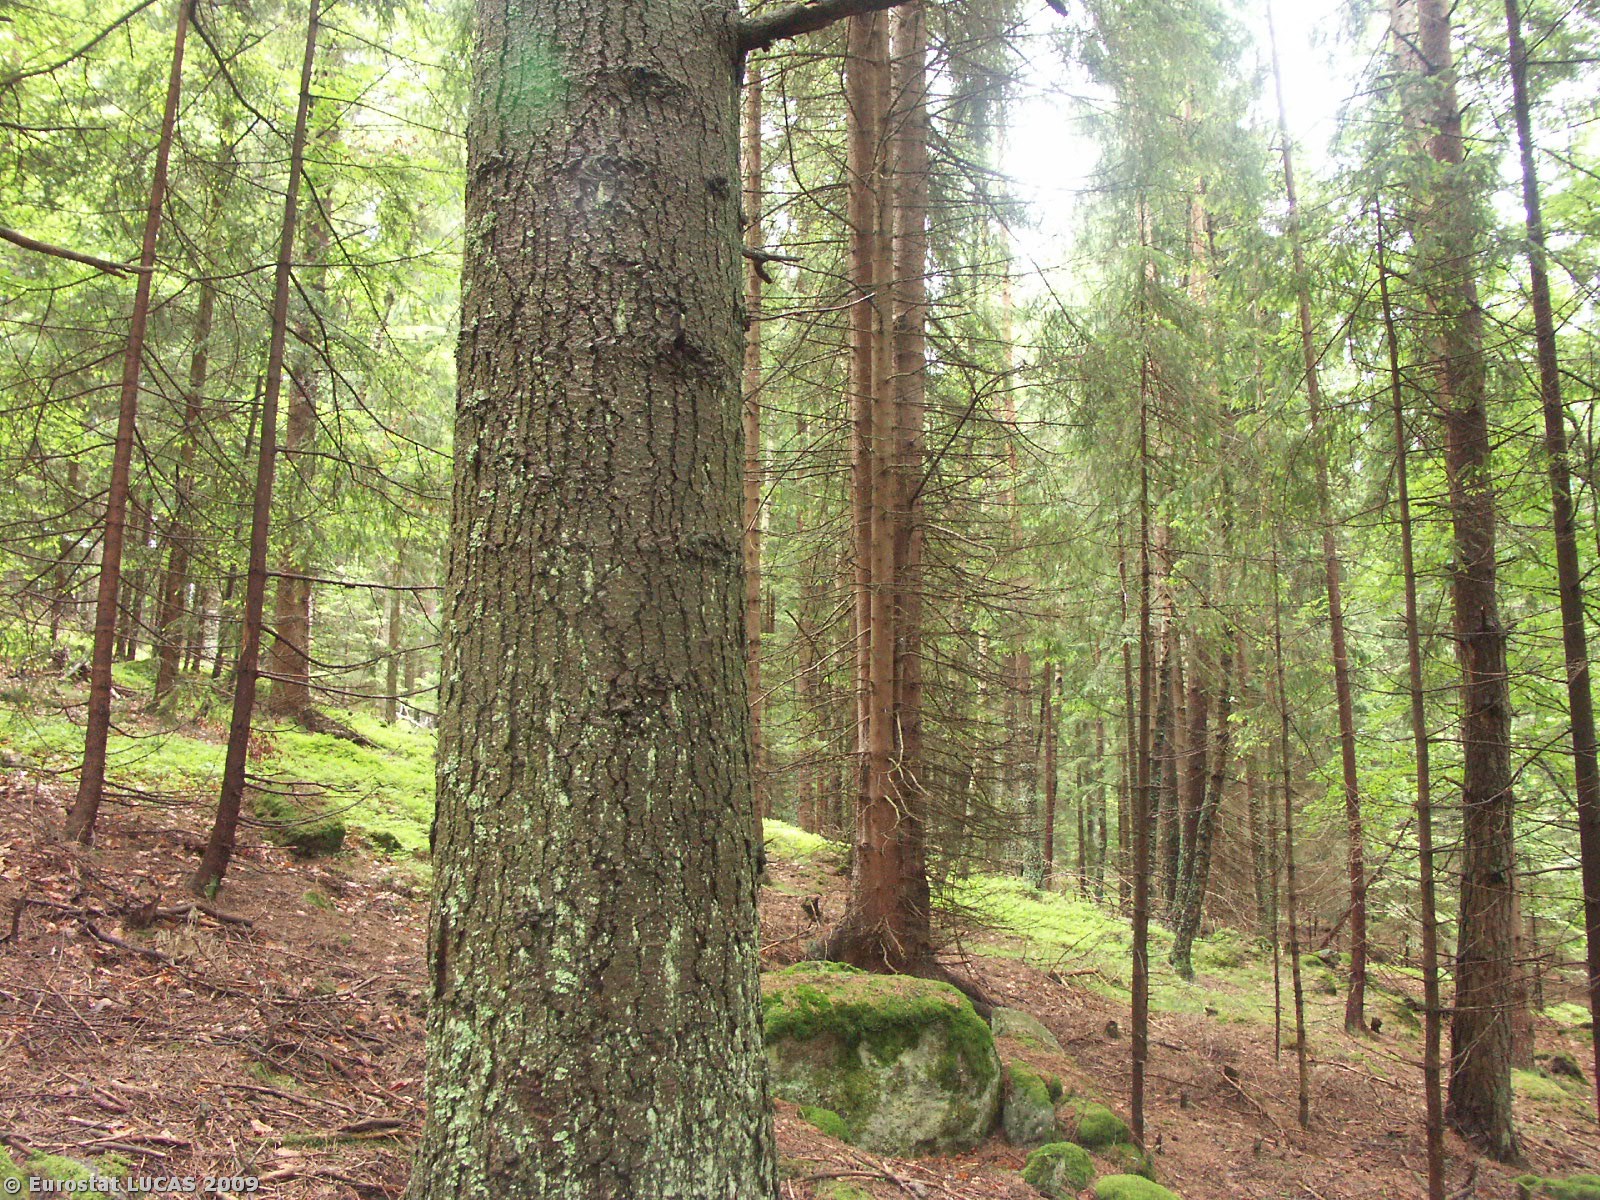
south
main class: Woodland
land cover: Coniferous woodland
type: hemiboreal forest and nemoral coniferous forest and mixed broadleaved-coniferous forest
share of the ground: > 75 %
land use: Forestry
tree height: > 5 m
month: June
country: CZ
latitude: 48.5913
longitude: 14.2712
